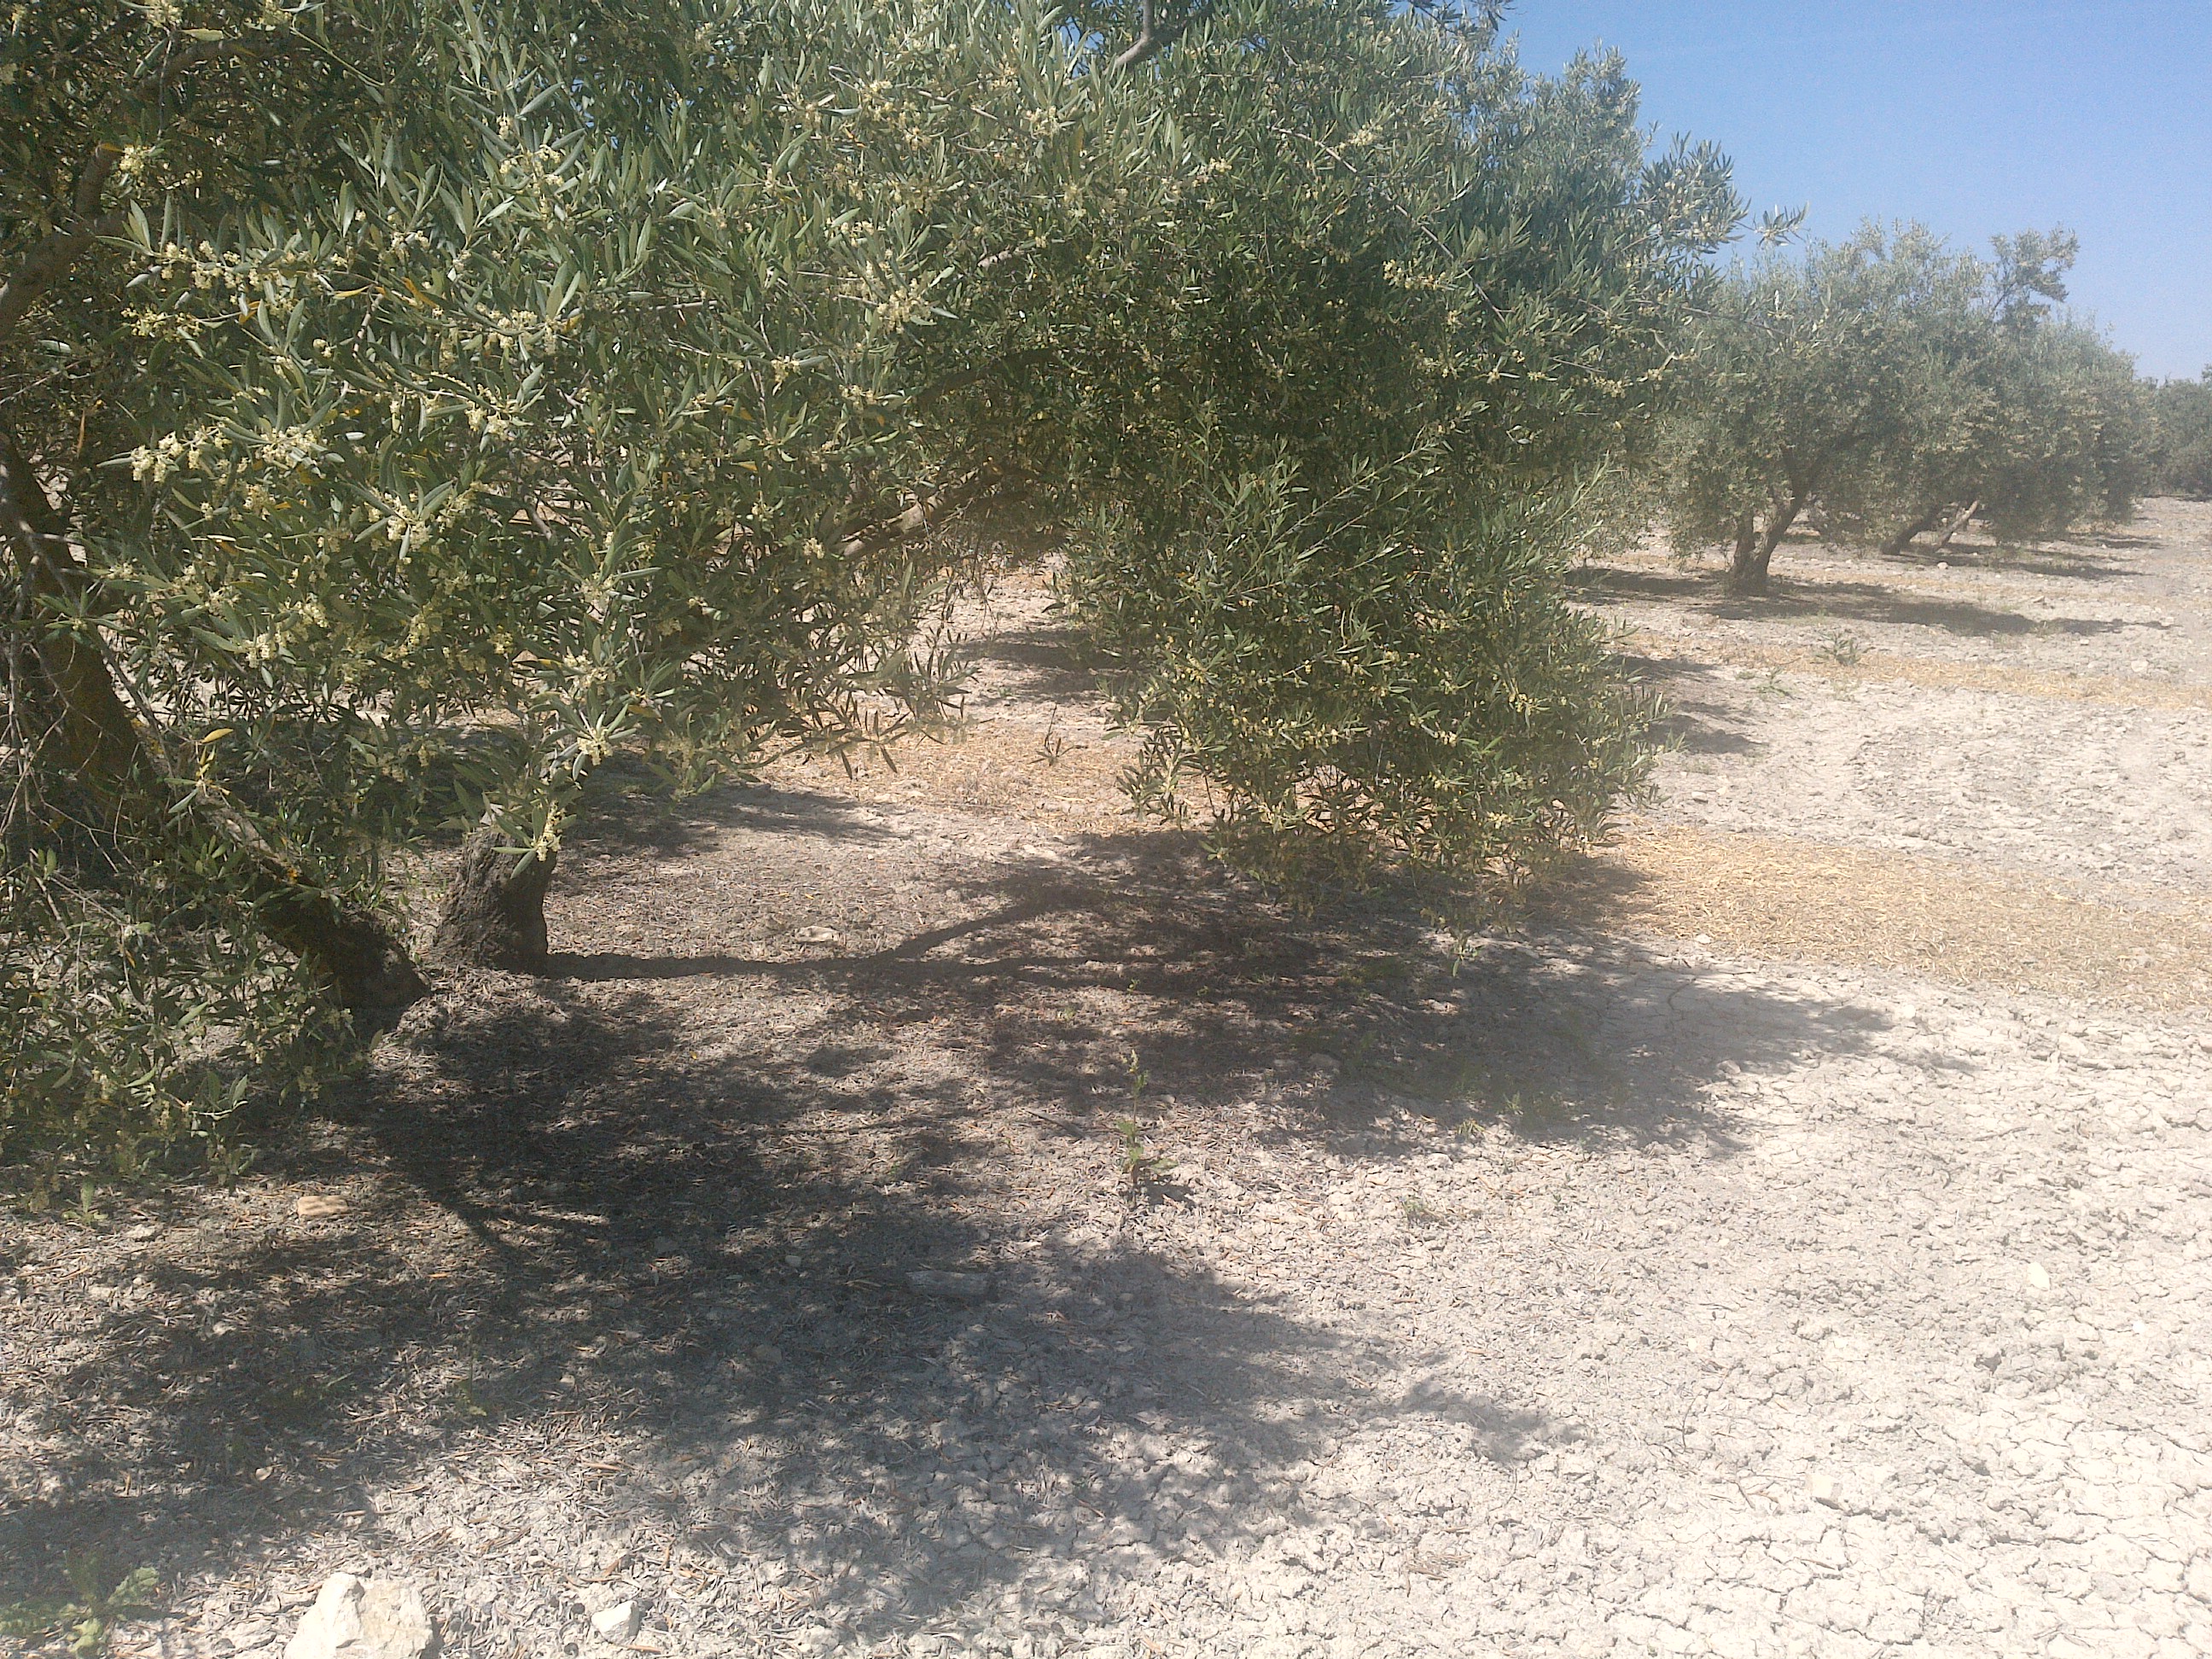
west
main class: Cropland
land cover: Olive groves
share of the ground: 50 - 75 %
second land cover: Other bare soil
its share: > 75 %
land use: Agriculture (excluding fallow land and kitchen gardens)
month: May
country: ES
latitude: 37.7160
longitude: -4.6095
